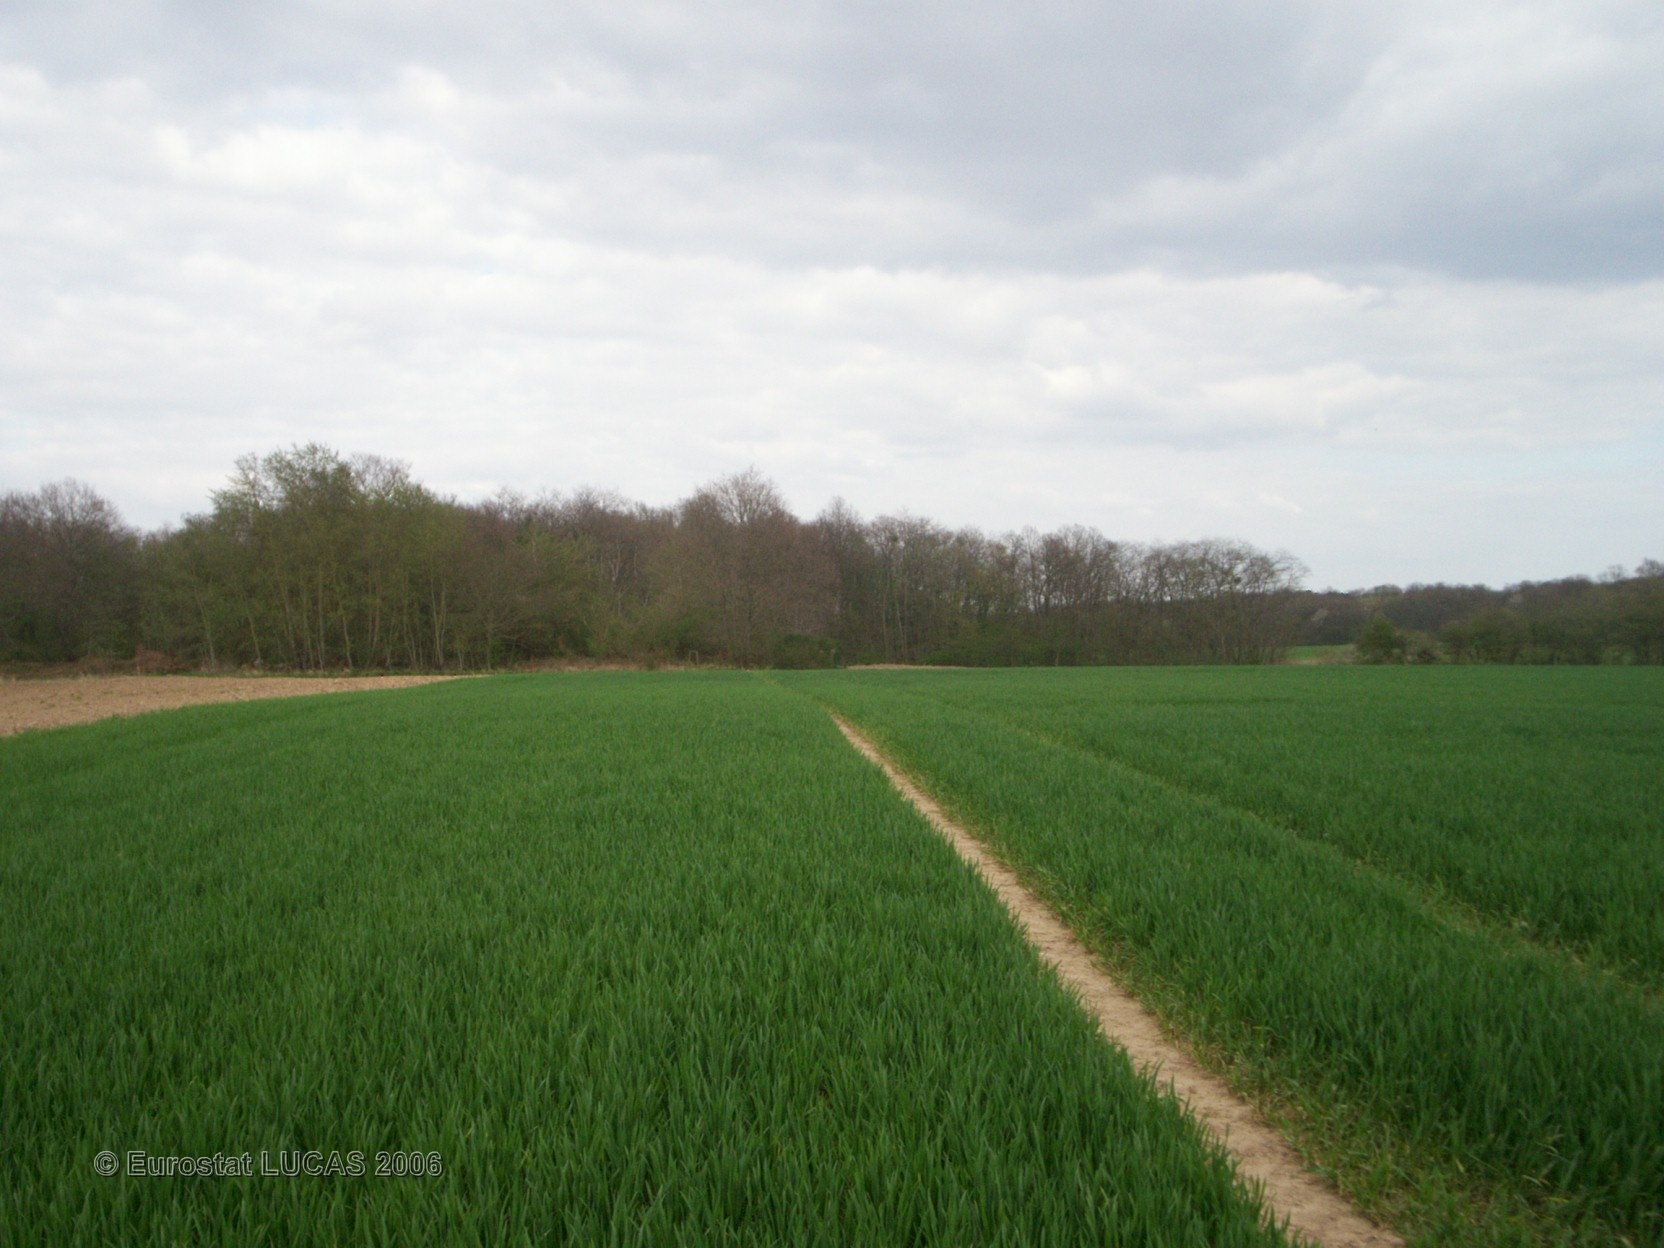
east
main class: Cropland
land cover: Common wheat
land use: Agriculture (excluding fallow land and kitchen gardens)
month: April
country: FR
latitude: 48.3008
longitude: 2.8873
